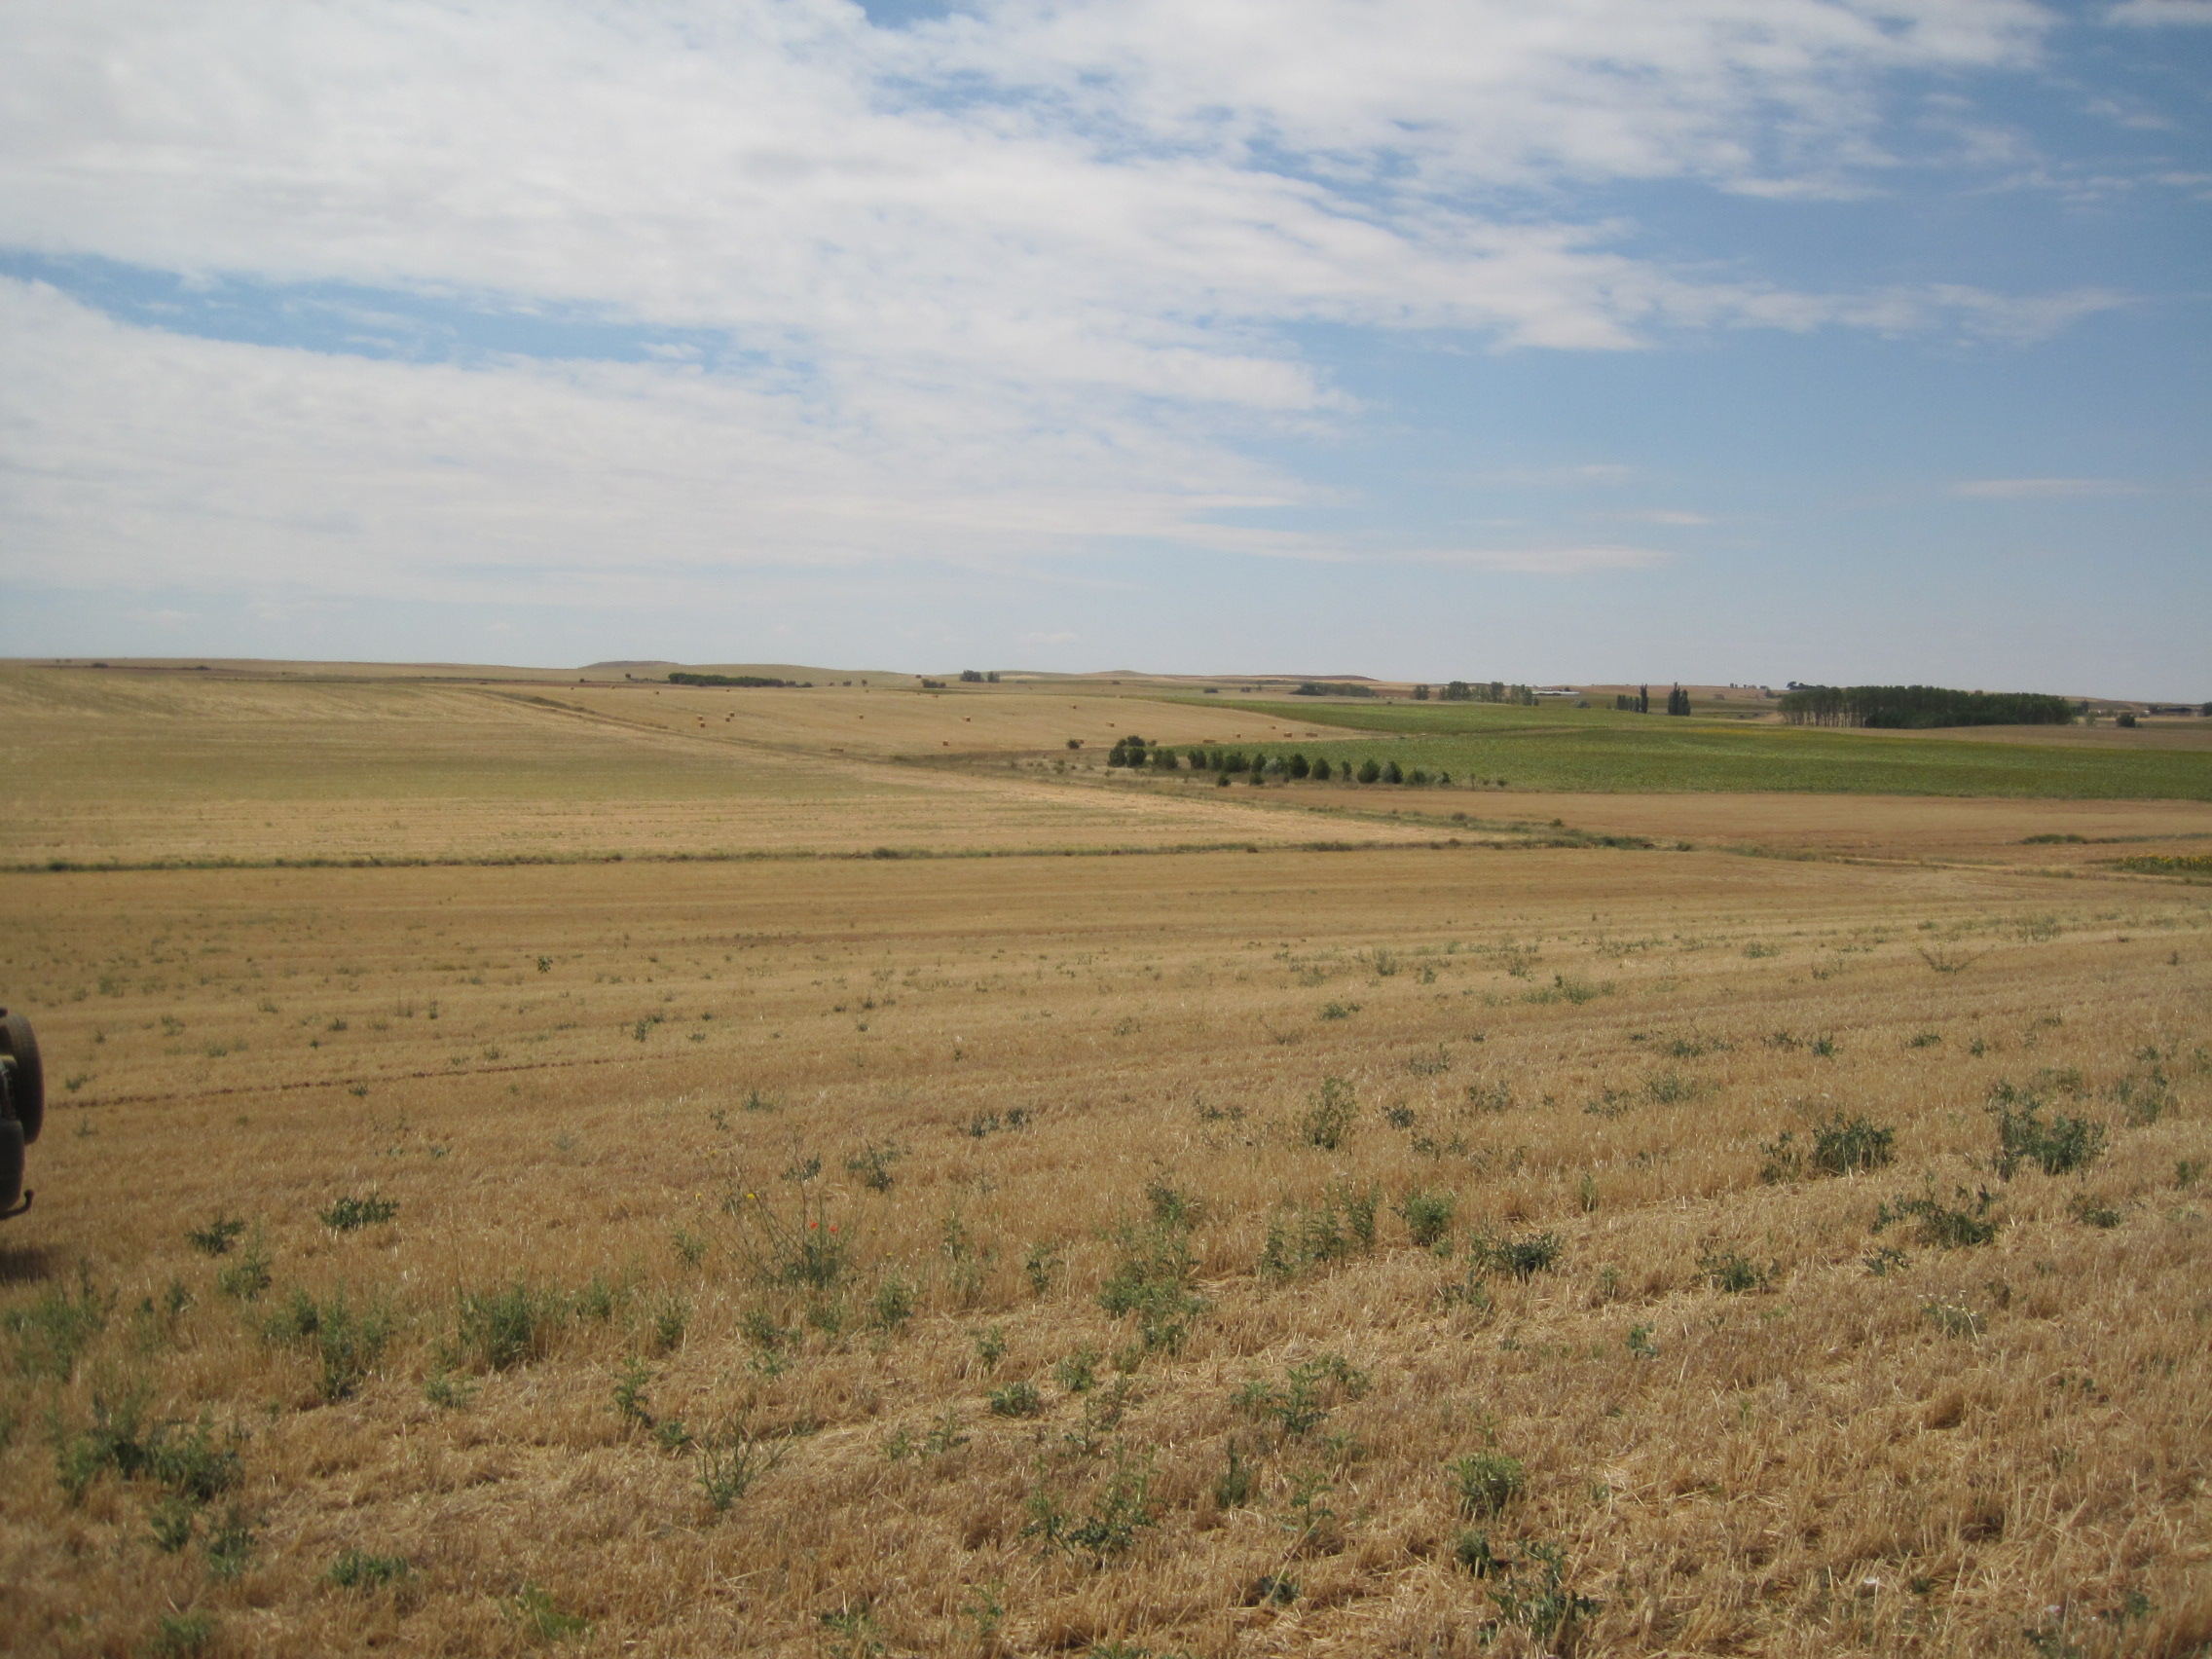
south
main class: Cropland
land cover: Barley
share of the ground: < 10 %
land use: Agriculture (excluding fallow land and kitchen gardens)
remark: Harvested field
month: July
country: ES
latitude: 42.0285
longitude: -5.2169
